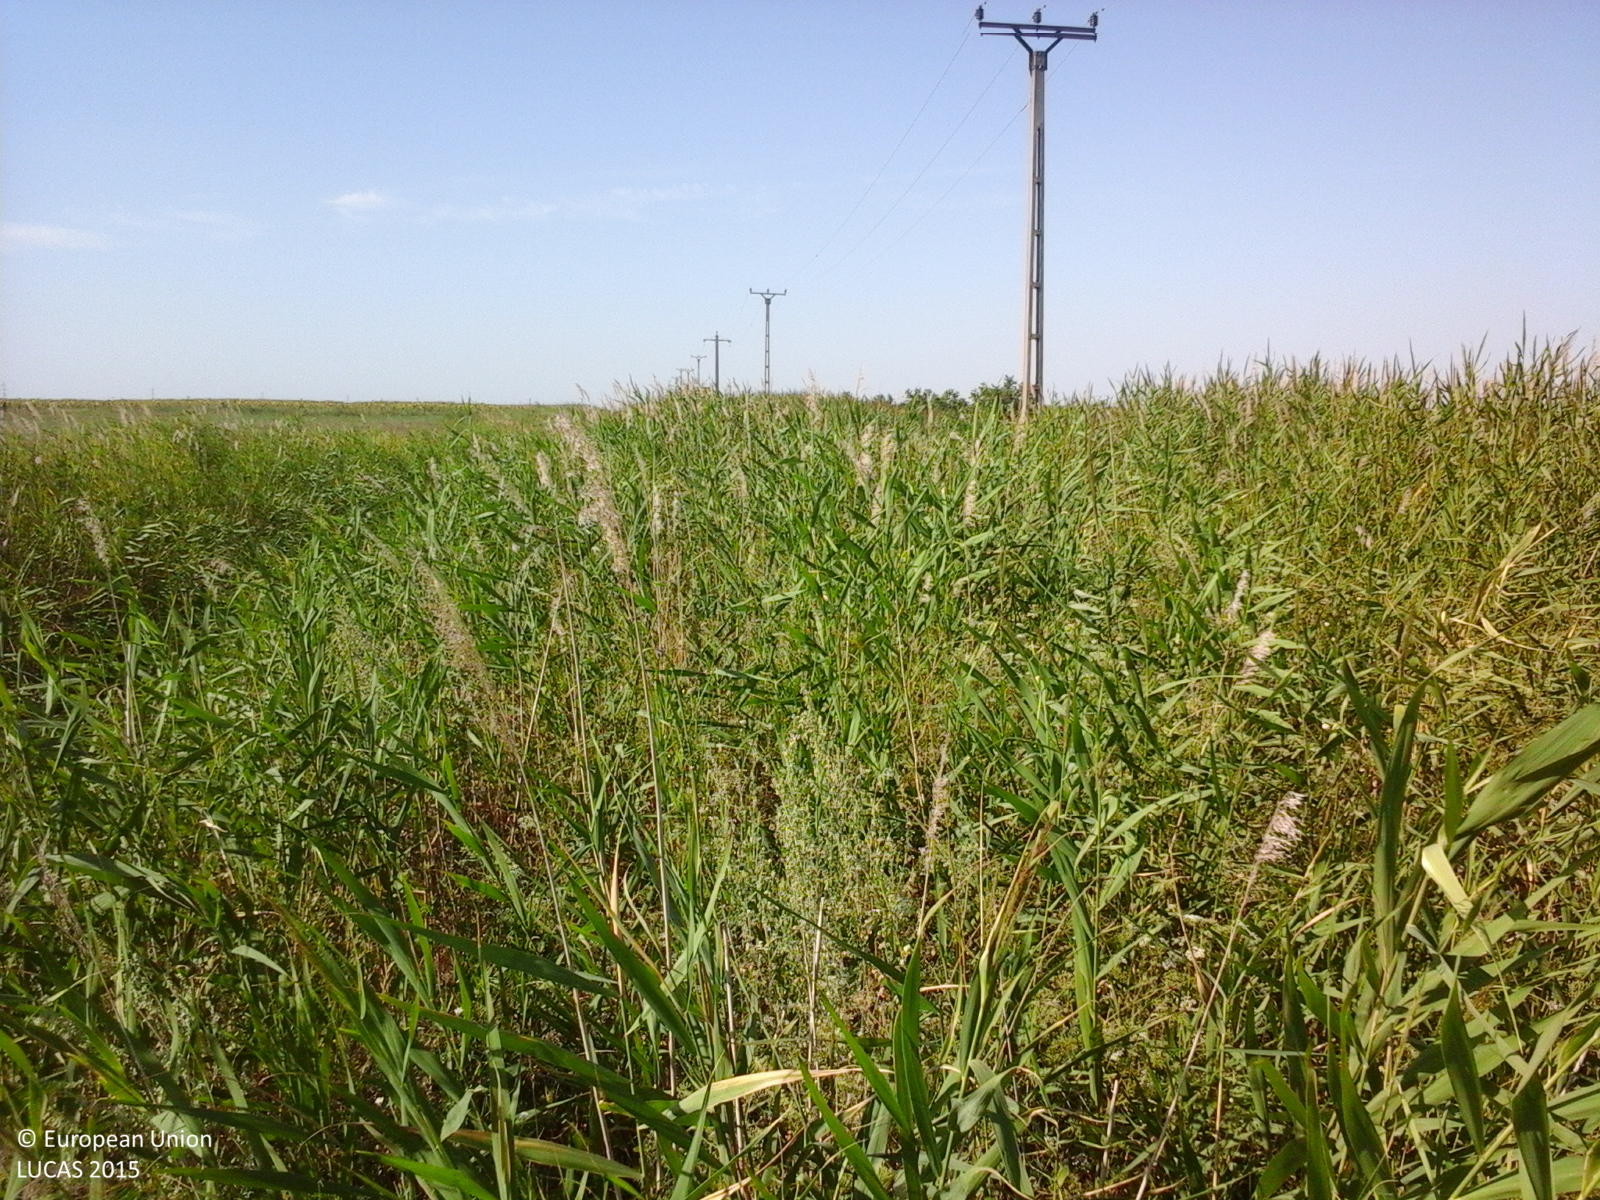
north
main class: Cropland
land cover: Temporary grasslands
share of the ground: > 75 %
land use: Agriculture (excluding fallow land and kitchen gardens)
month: August
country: RO
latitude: 45.5849
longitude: 27.4427
